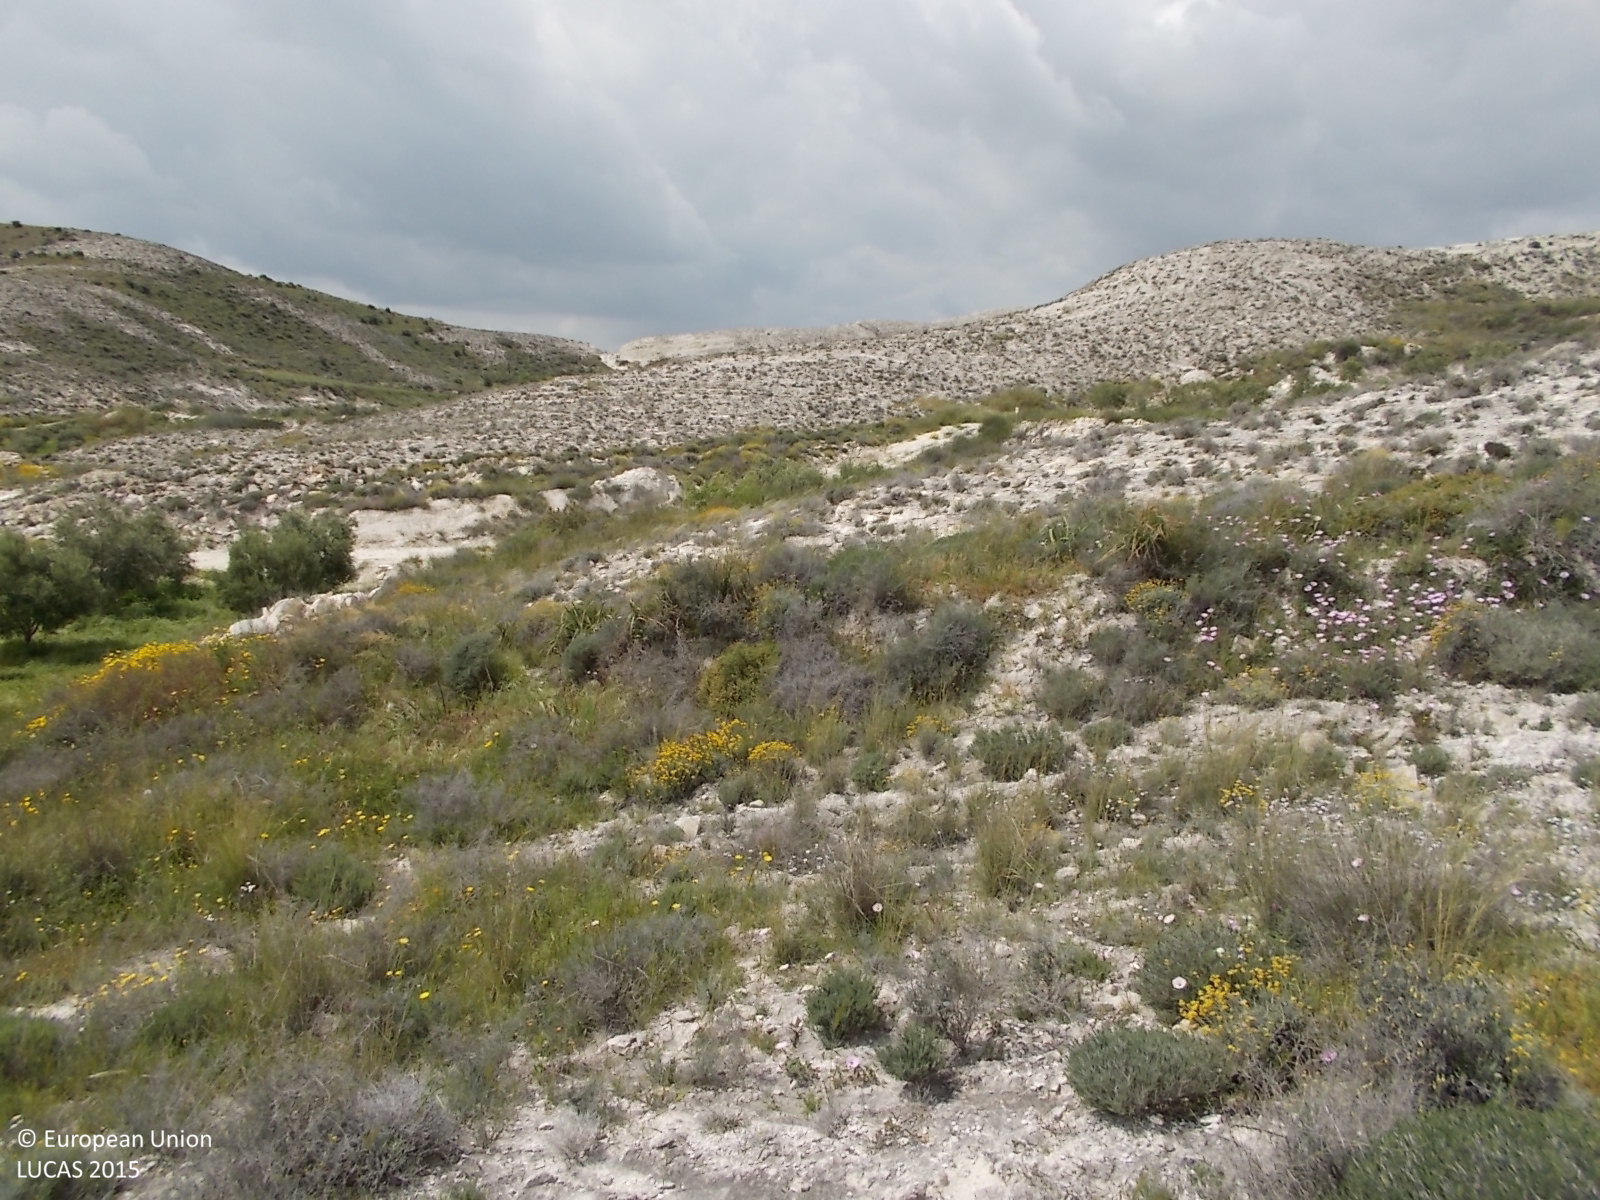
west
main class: Shrubland
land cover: Shrubland without tree cover
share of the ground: 25 - 50 %
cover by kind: shrubs 50 %, unconsolidated bare surface 50 %
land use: Semi-natural and natural areas not in use
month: April
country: CY
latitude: 34.9861
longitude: 33.5629
